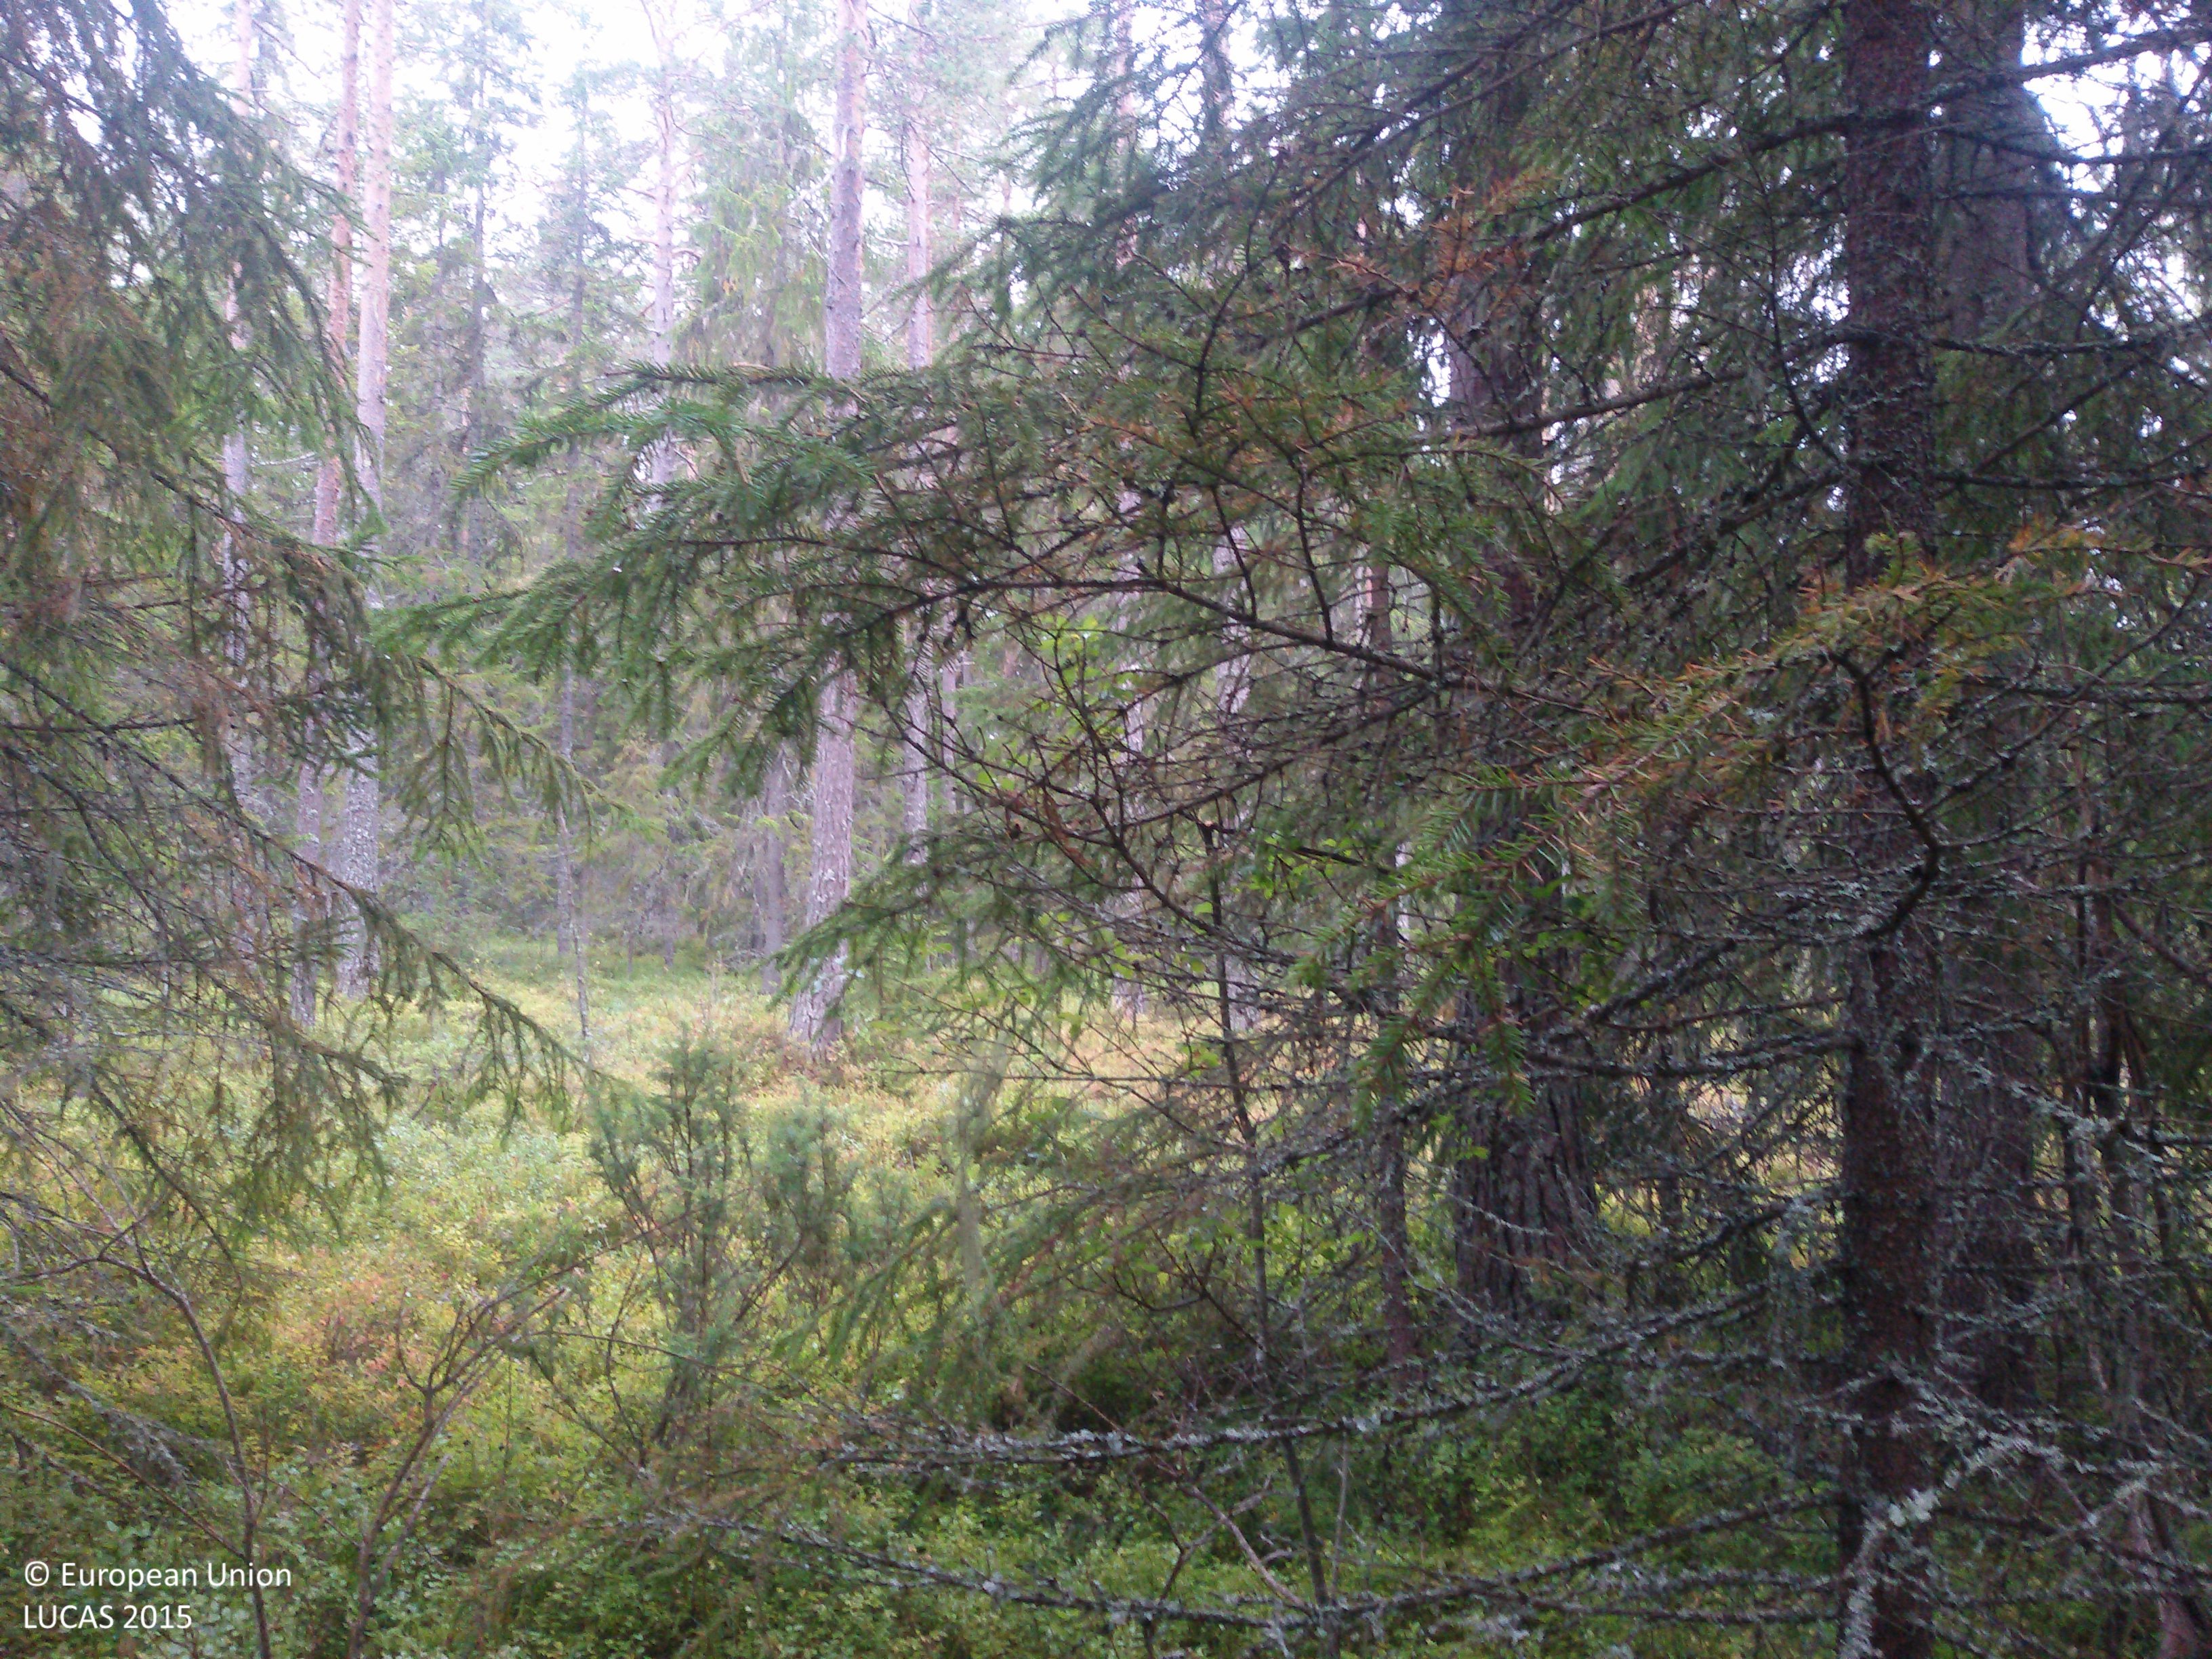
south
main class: Woodland
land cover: Other coniferous woodland
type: boreal forest
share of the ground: 50 - 75 %
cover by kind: coniferous forest trees 70 %, herbaceous plants 20 %, lichens and mosses 10 %
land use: Forestry
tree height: > 5 m
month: September
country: SE
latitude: 61.0910
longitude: 14.2334
